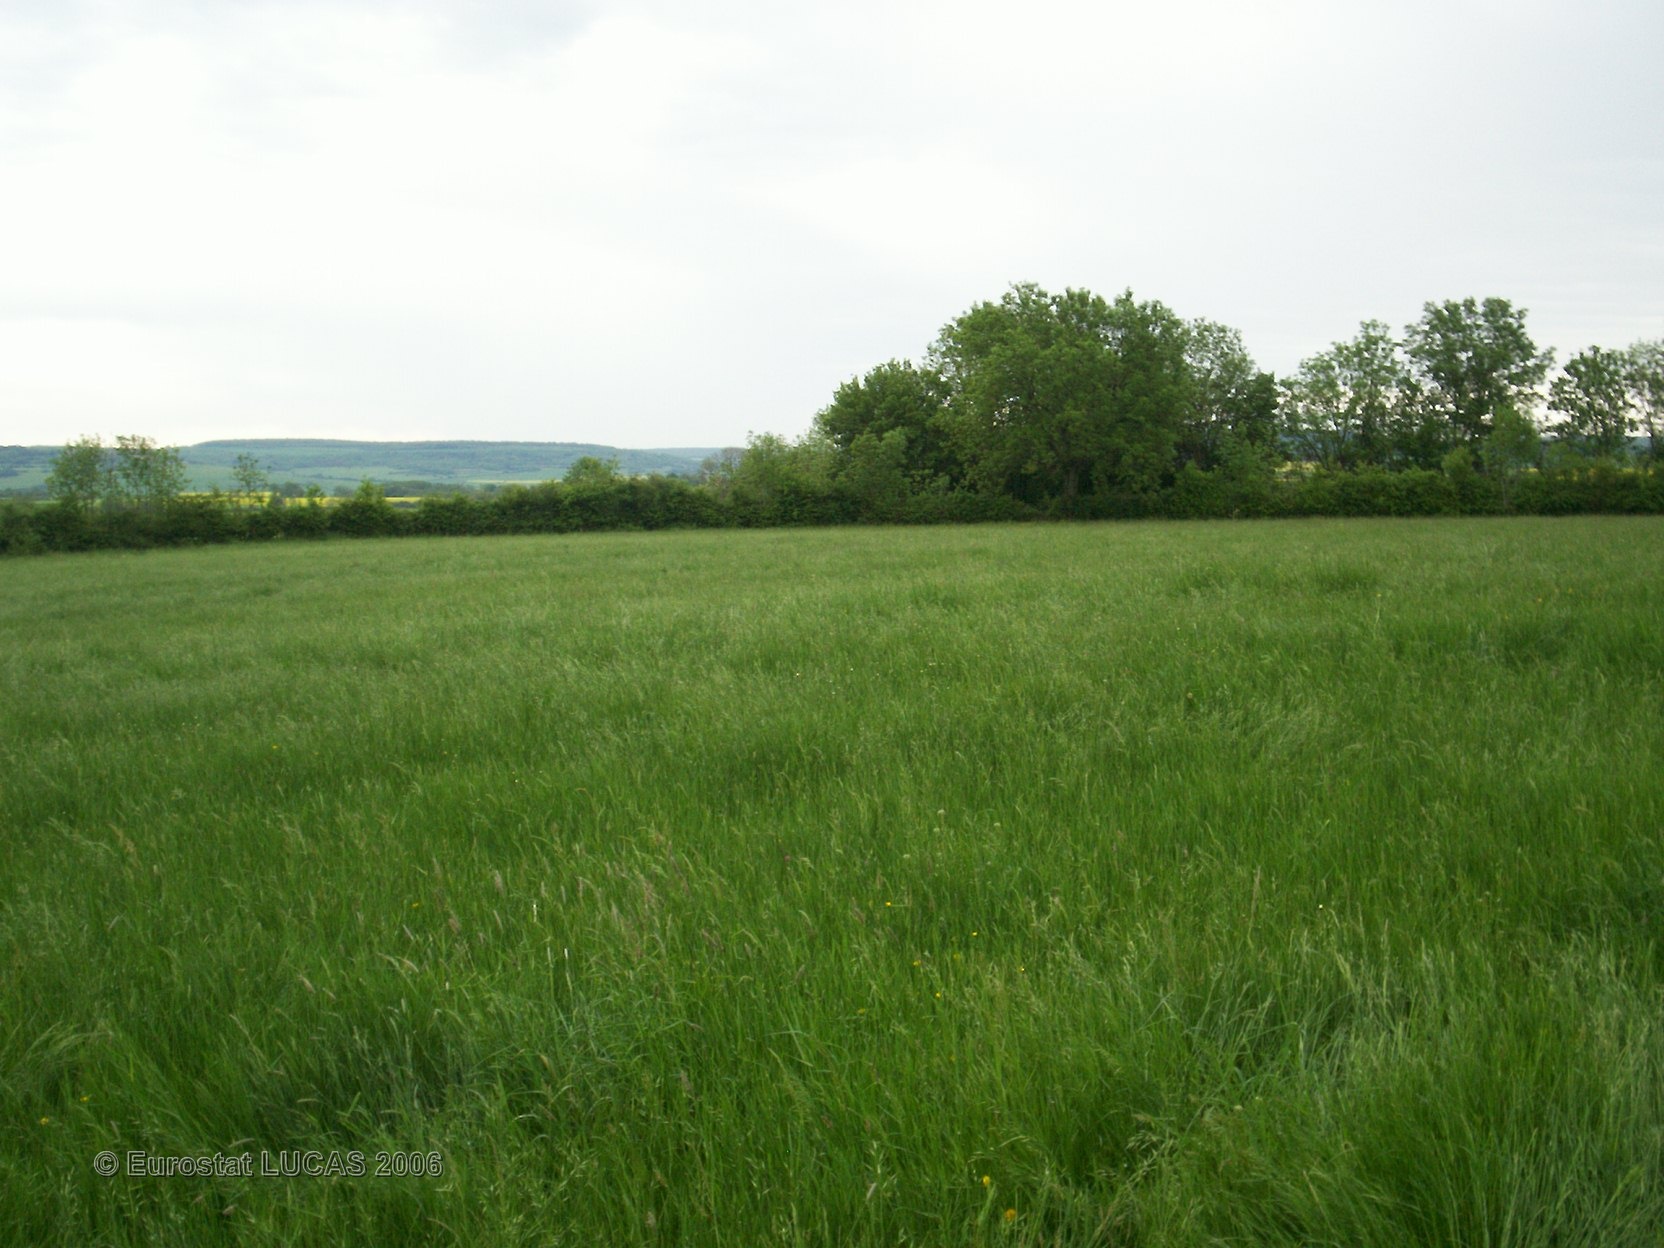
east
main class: Grassland
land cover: Grassland without tree/shrub cover
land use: Agriculture (excluding fallow land and kitchen gardens)
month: May
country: FR
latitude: 47.2061
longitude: 4.5739
